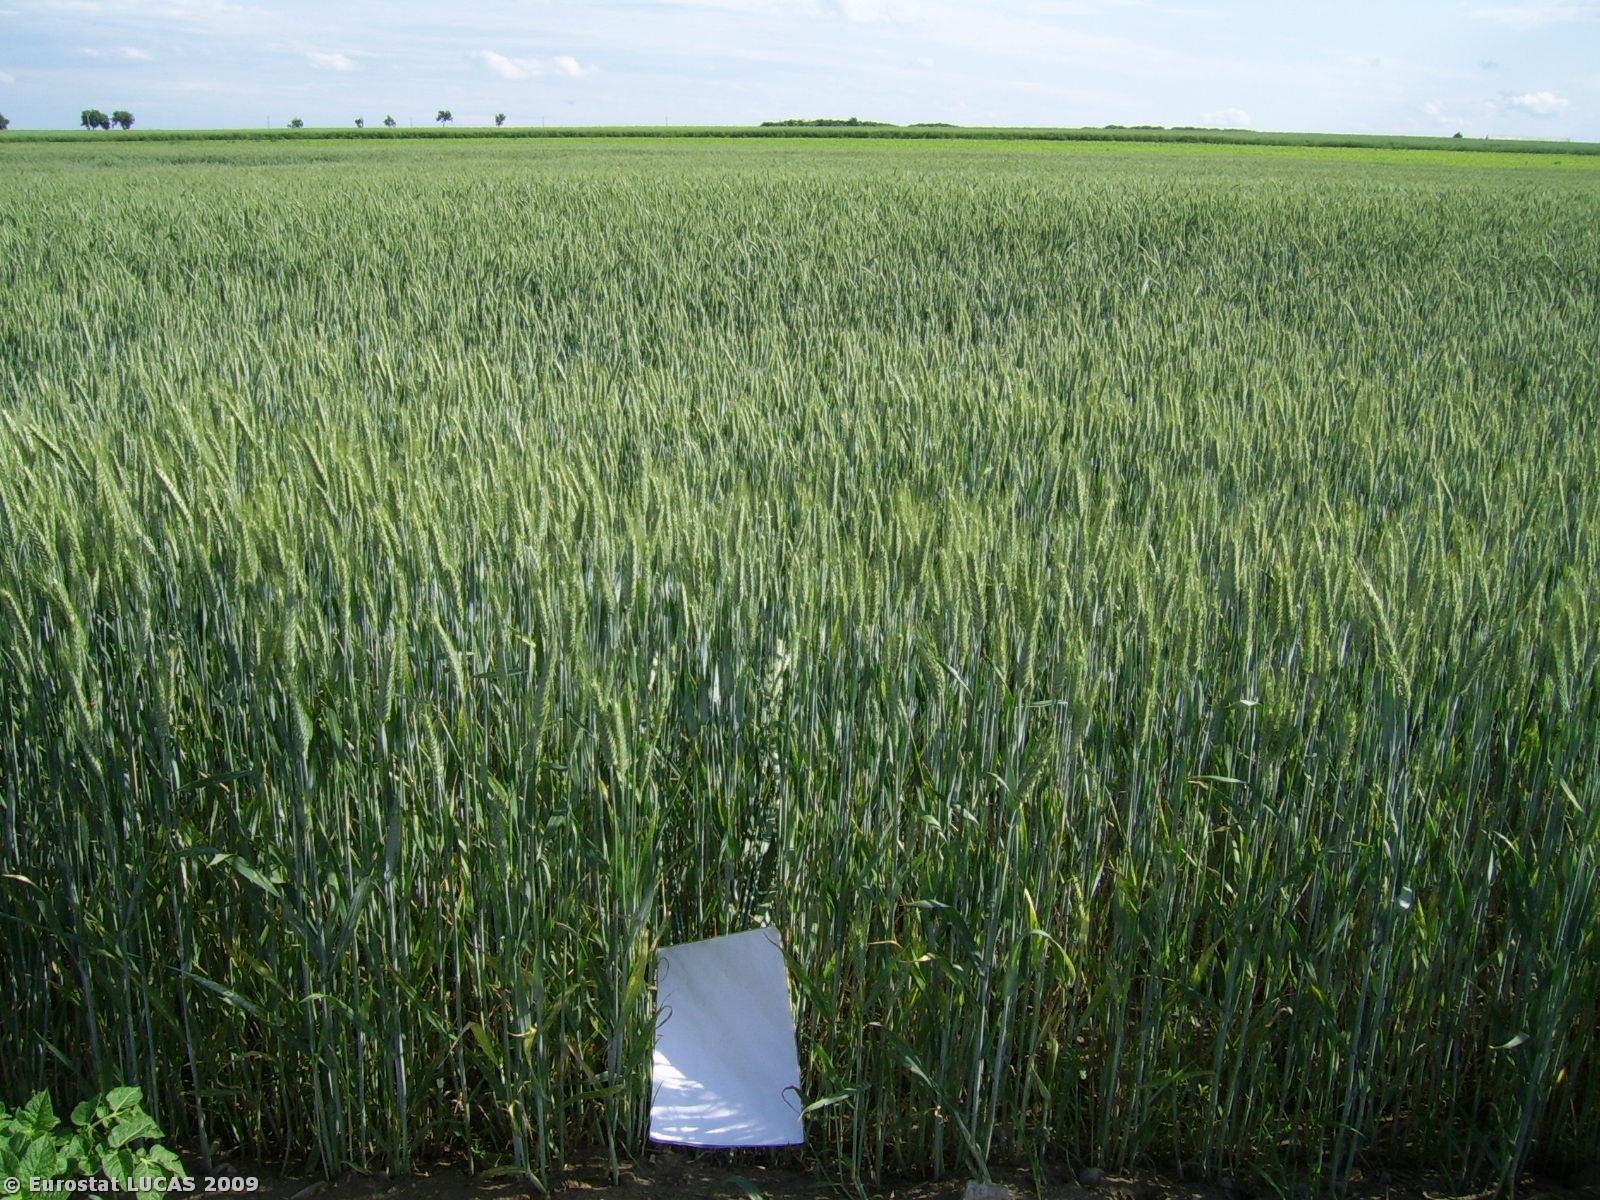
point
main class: Cropland
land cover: Triticale
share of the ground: > 75 %
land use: Agriculture (excluding fallow land and kitchen gardens)
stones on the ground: < 10 %
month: June
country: PL
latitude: 51.8886
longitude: 17.7586
